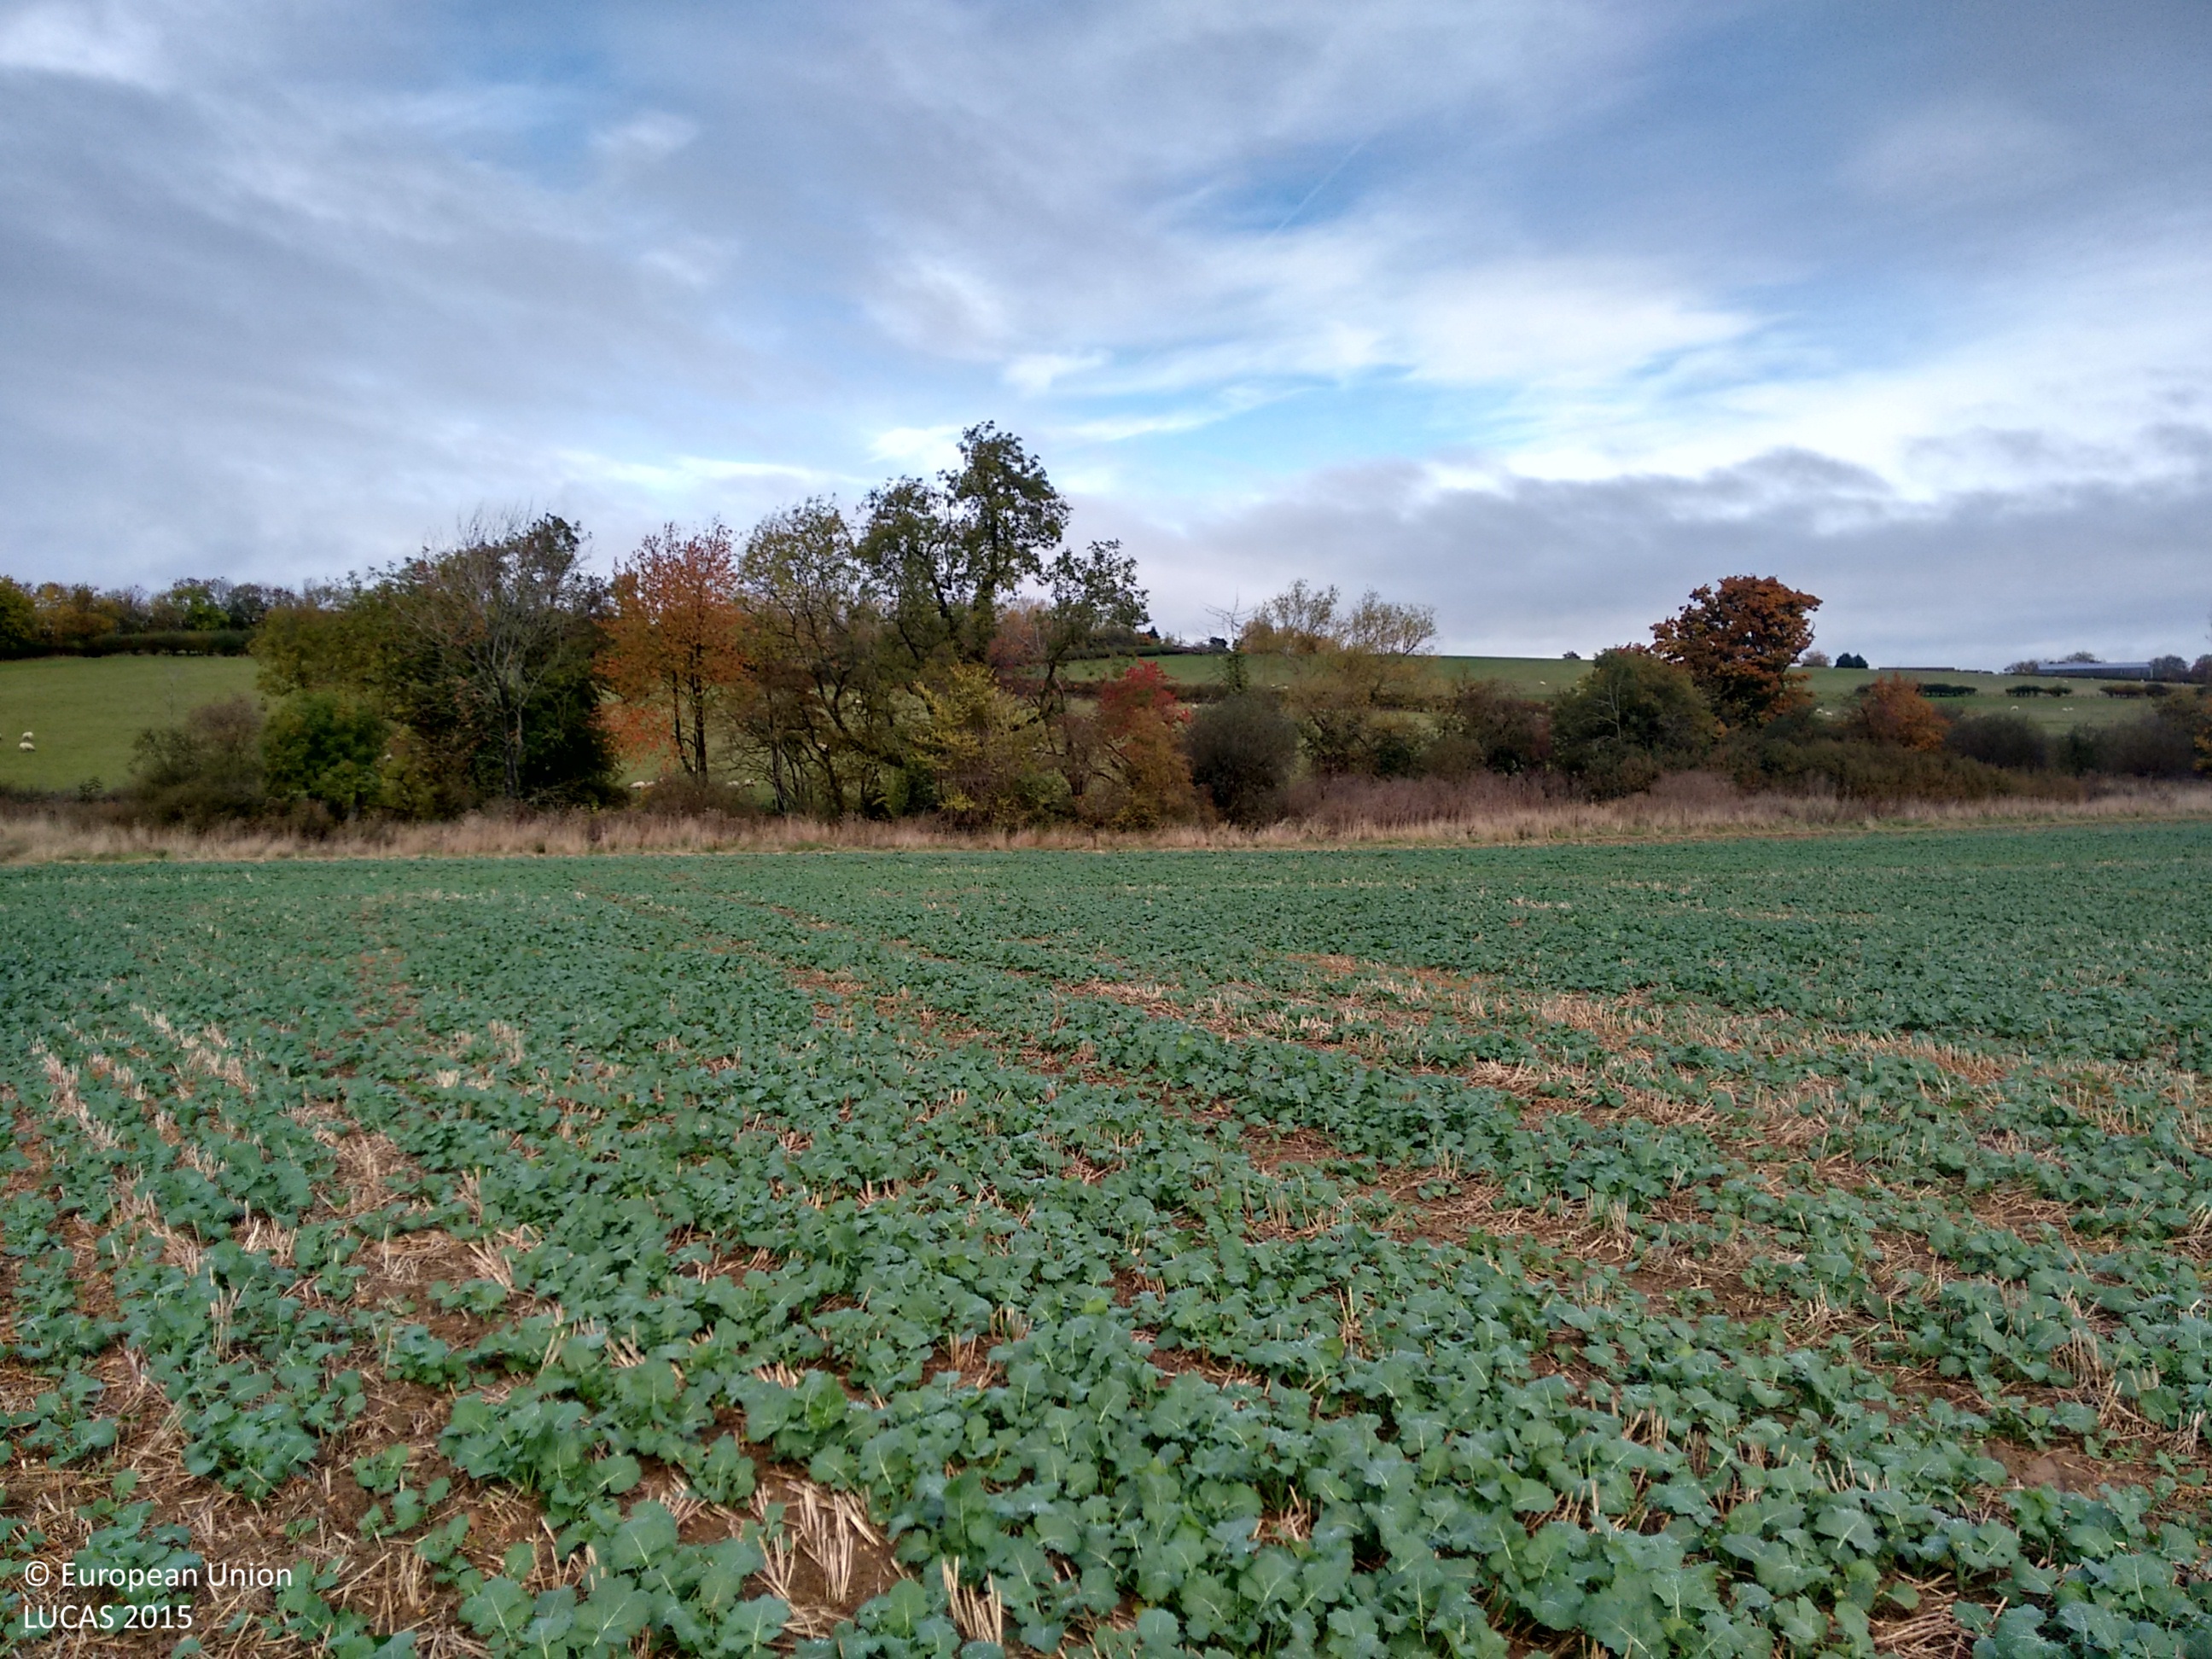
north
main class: Cropland
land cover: Rape and turnip rape
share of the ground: 50 - 75 %
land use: Agriculture (excluding fallow land and kitchen gardens)
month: October
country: GB
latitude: 52.0356
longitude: -1.6718
